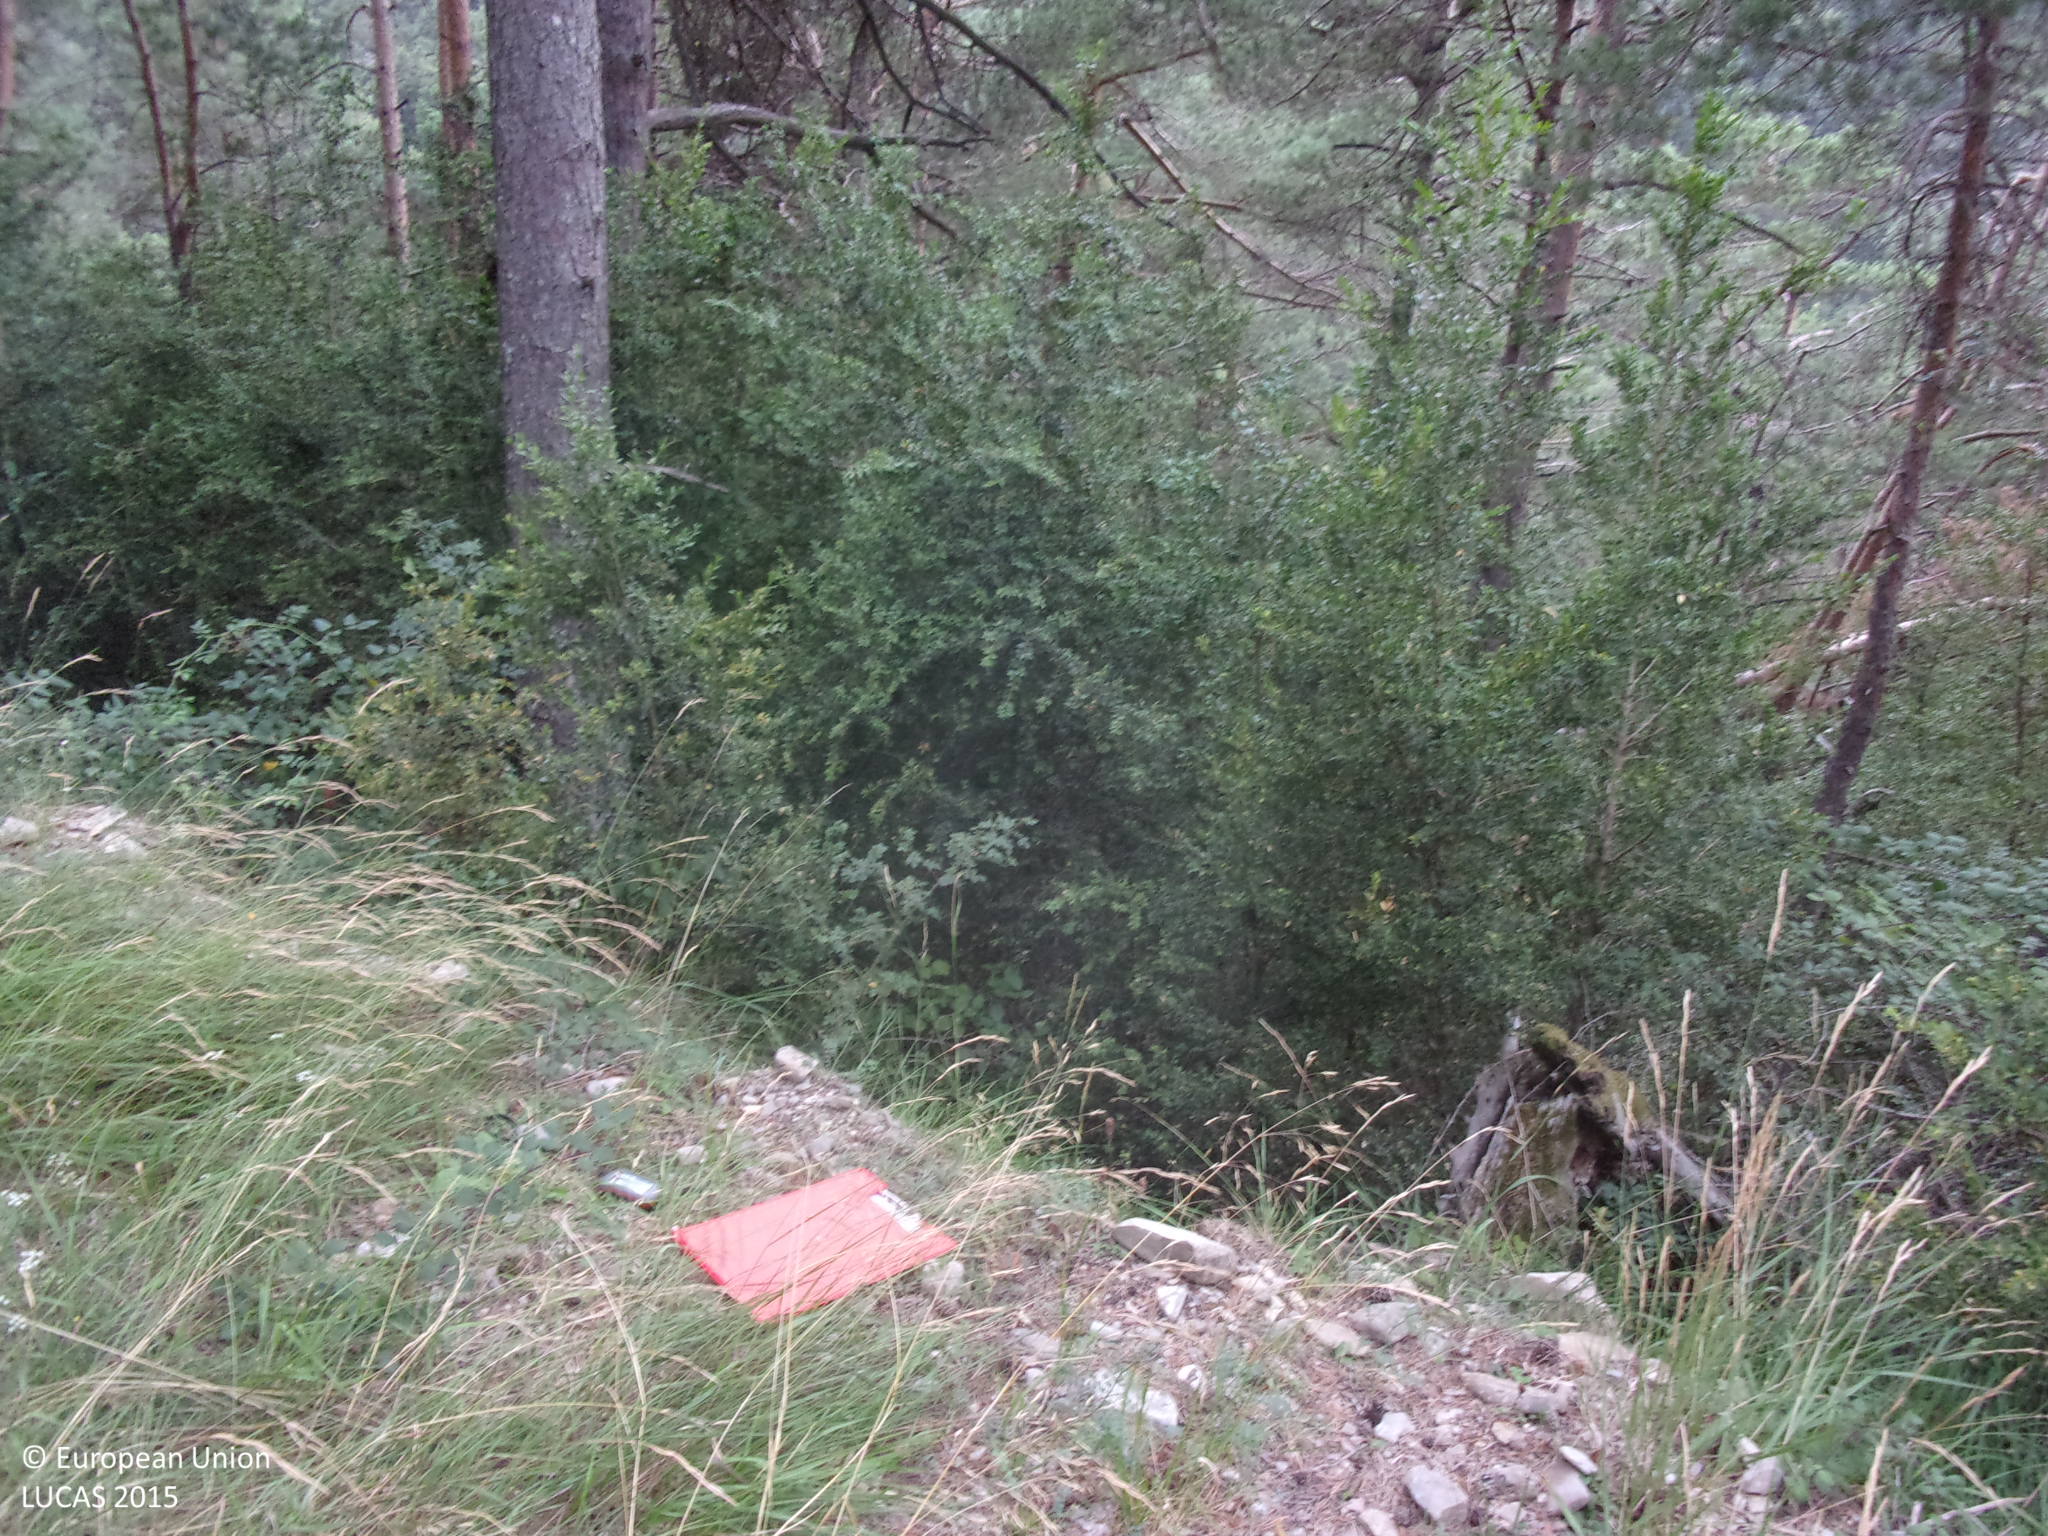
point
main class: Woodland
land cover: Pine dominated coniferous woodland
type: coniferous forest of the mediterranean region
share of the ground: > 75 %
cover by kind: coniferous forest trees 100 %
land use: Forestry
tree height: > 5 m
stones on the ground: 10 - 25 %
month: August
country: ES
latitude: 42.6010
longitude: -0.4721
